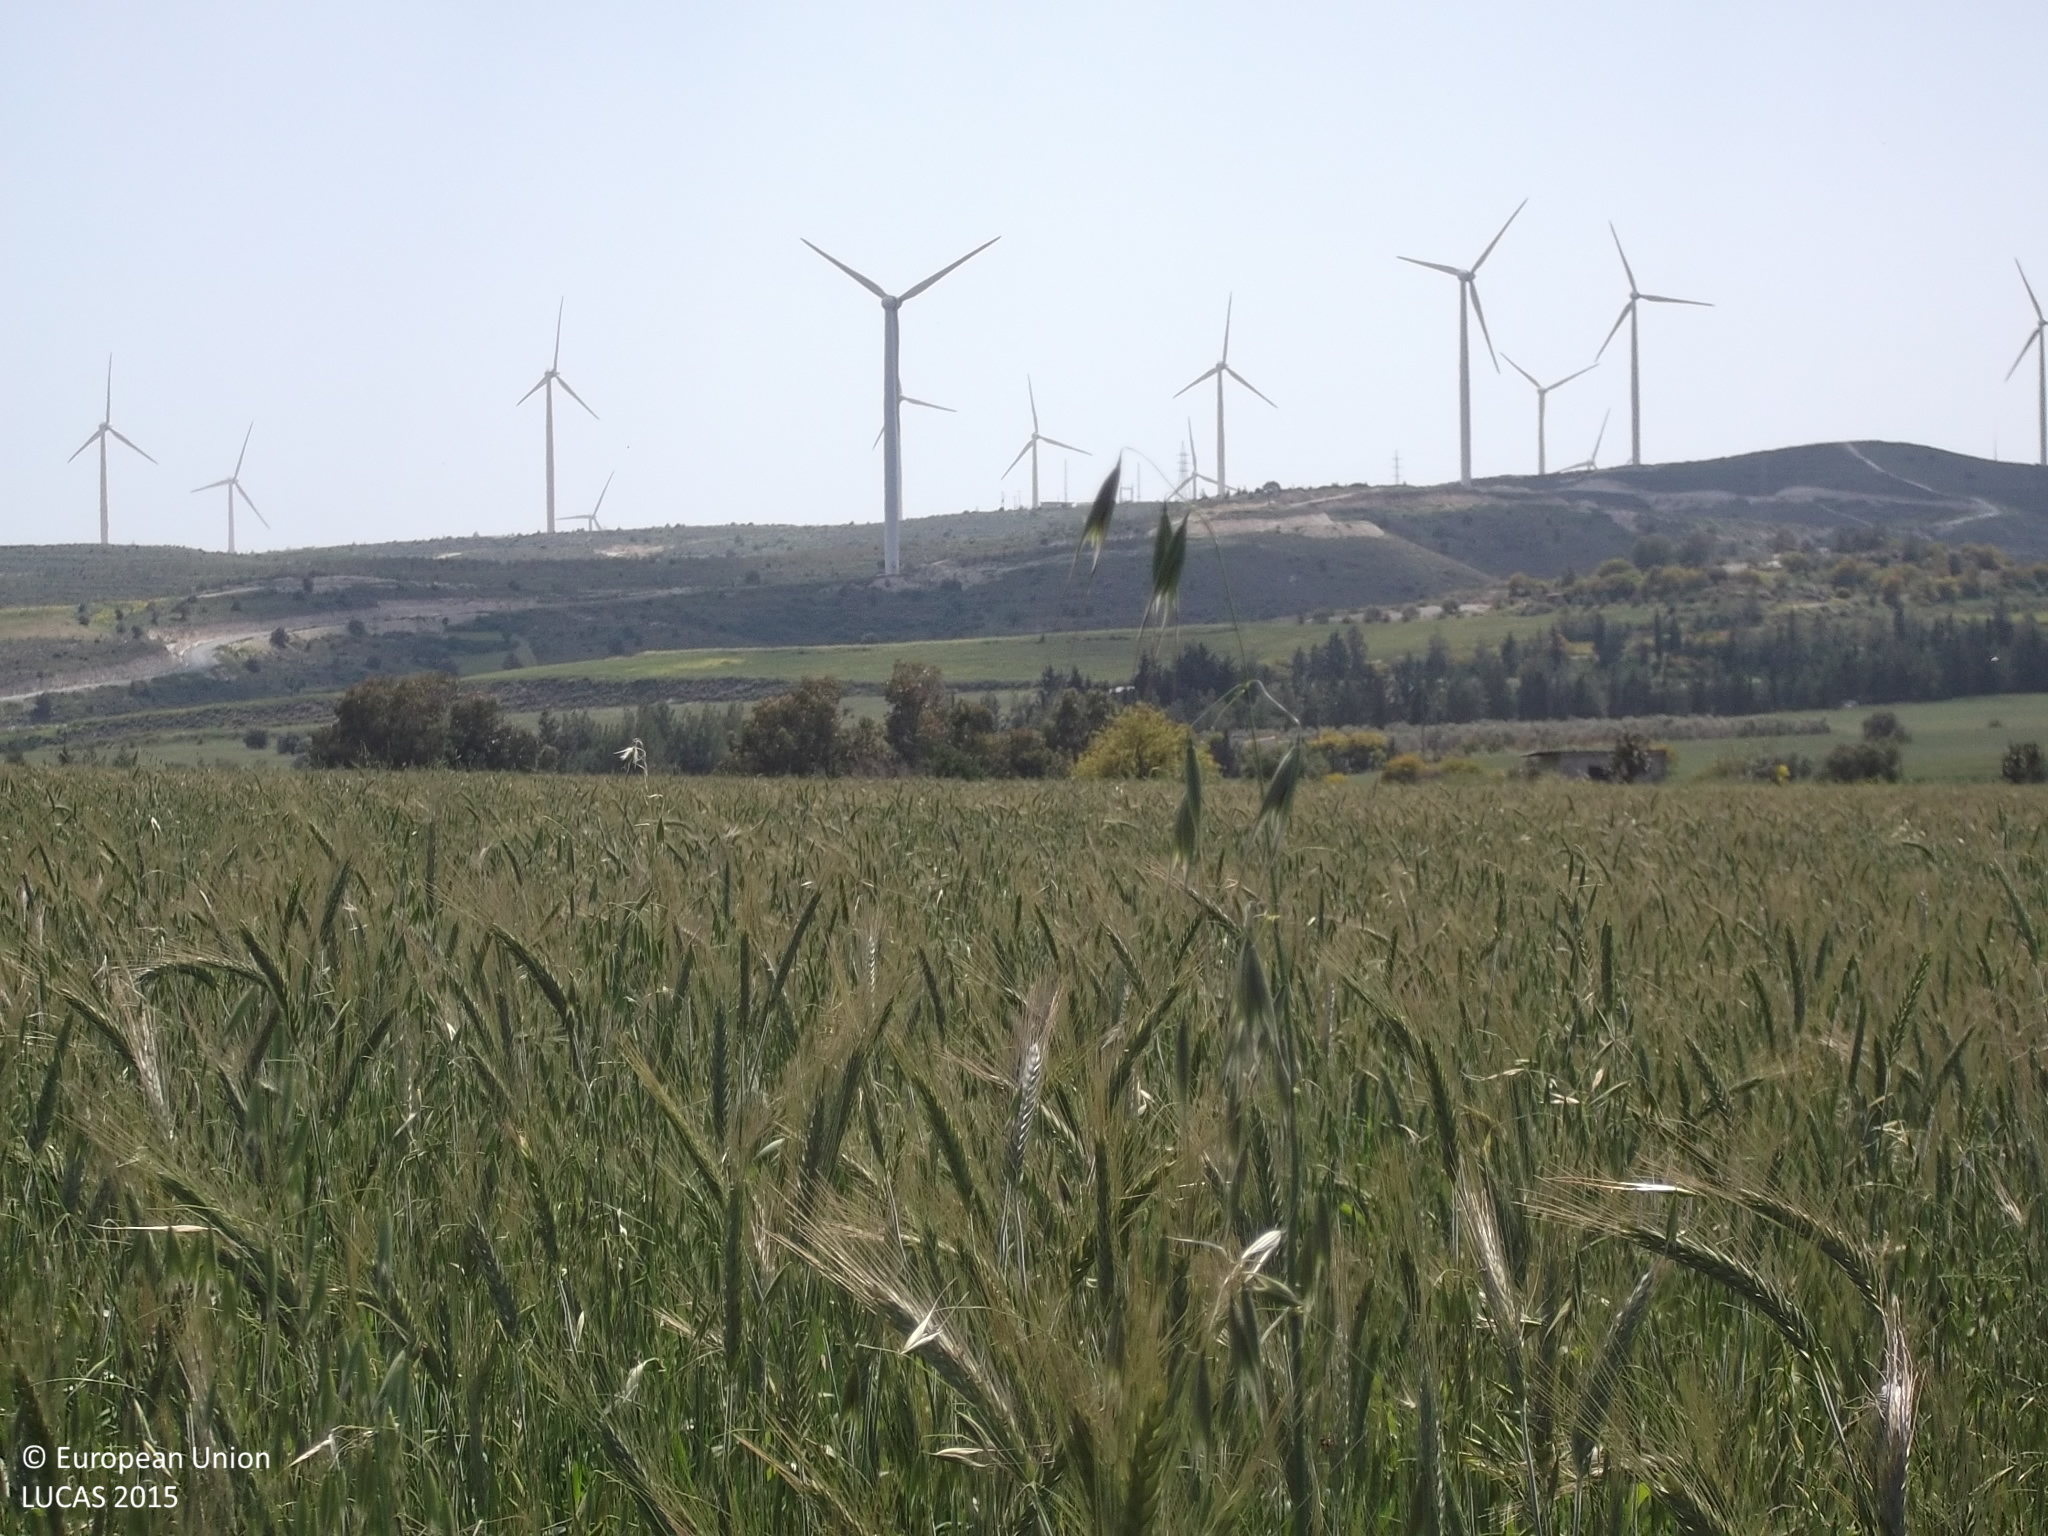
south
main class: Cropland
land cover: Common wheat
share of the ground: > 75 %
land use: Agriculture (excluding fallow land and kitchen gardens)
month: April
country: CY
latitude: 34.8997
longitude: 33.5342
